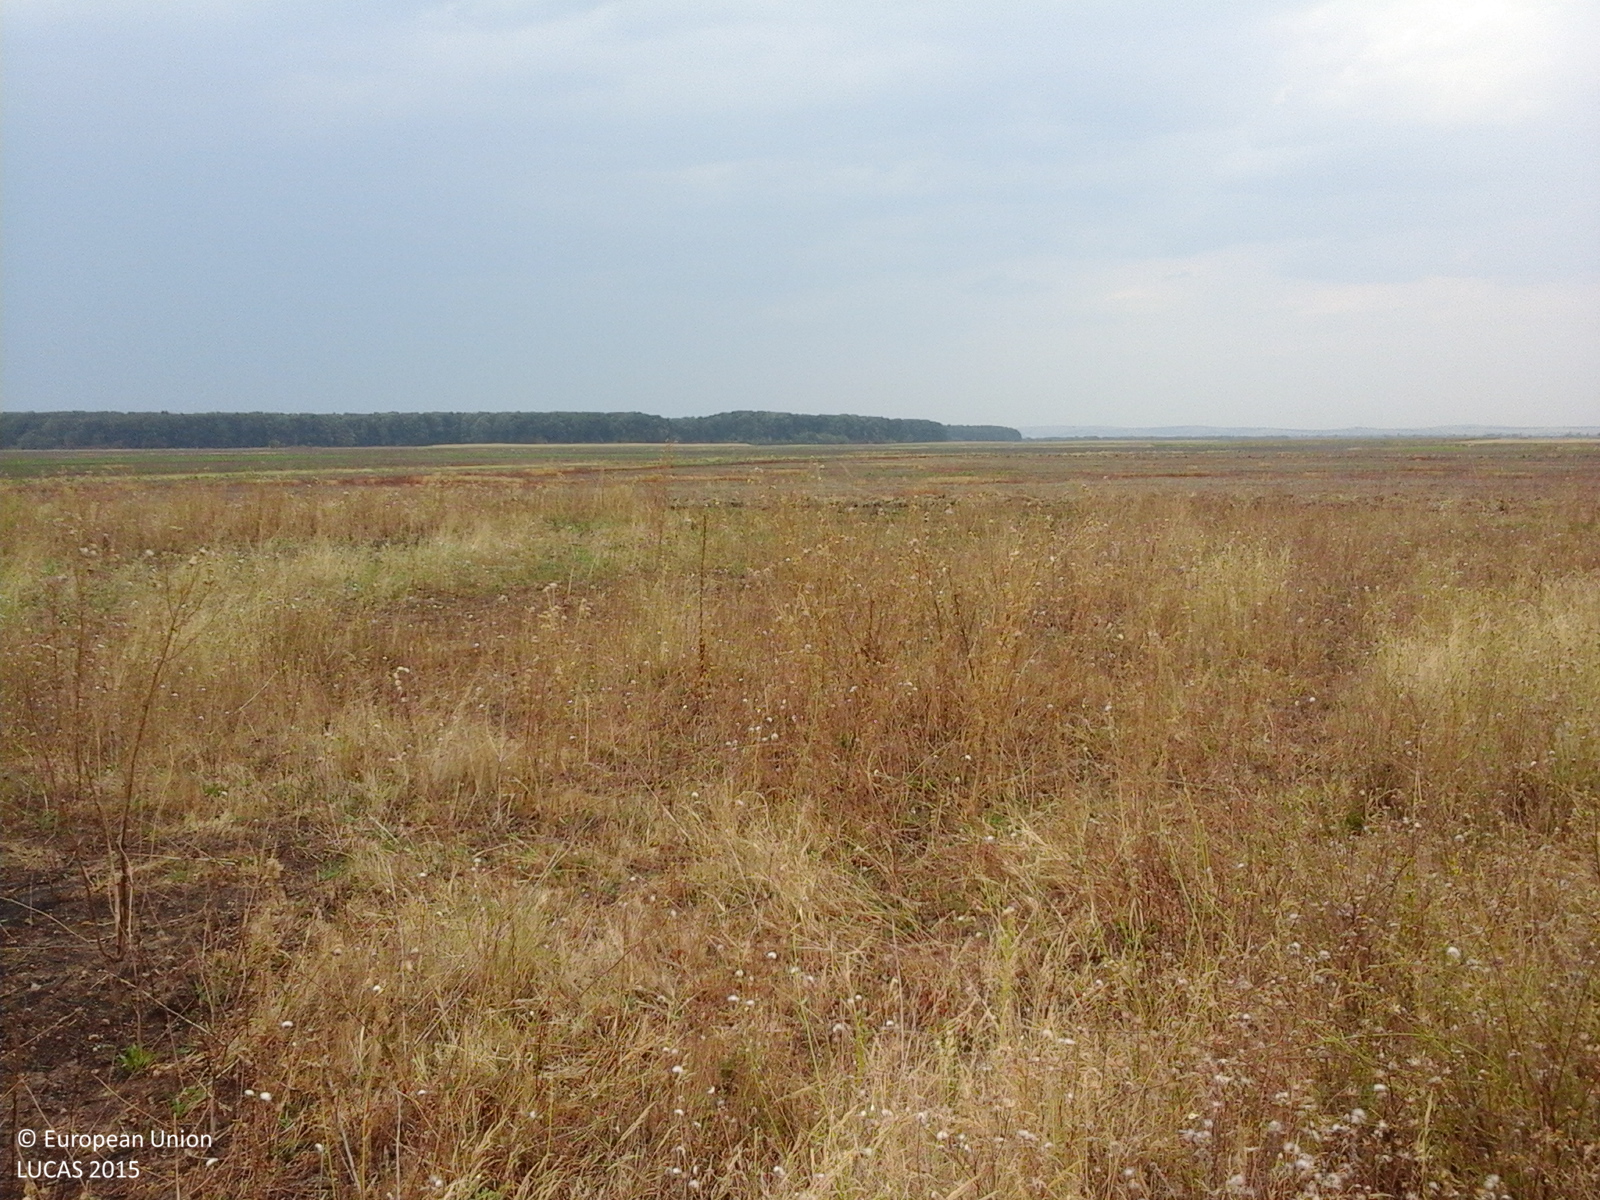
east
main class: Grassland
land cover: Spontaneously vegetated surfaces
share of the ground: > 75 %
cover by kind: herbaceous plants 100 %
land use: Fallow land
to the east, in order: Spontaneously vegetated surfaces; Common wheat; Tracks; Common wheat
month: August
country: RO
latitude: 44.4546
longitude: 22.7469
